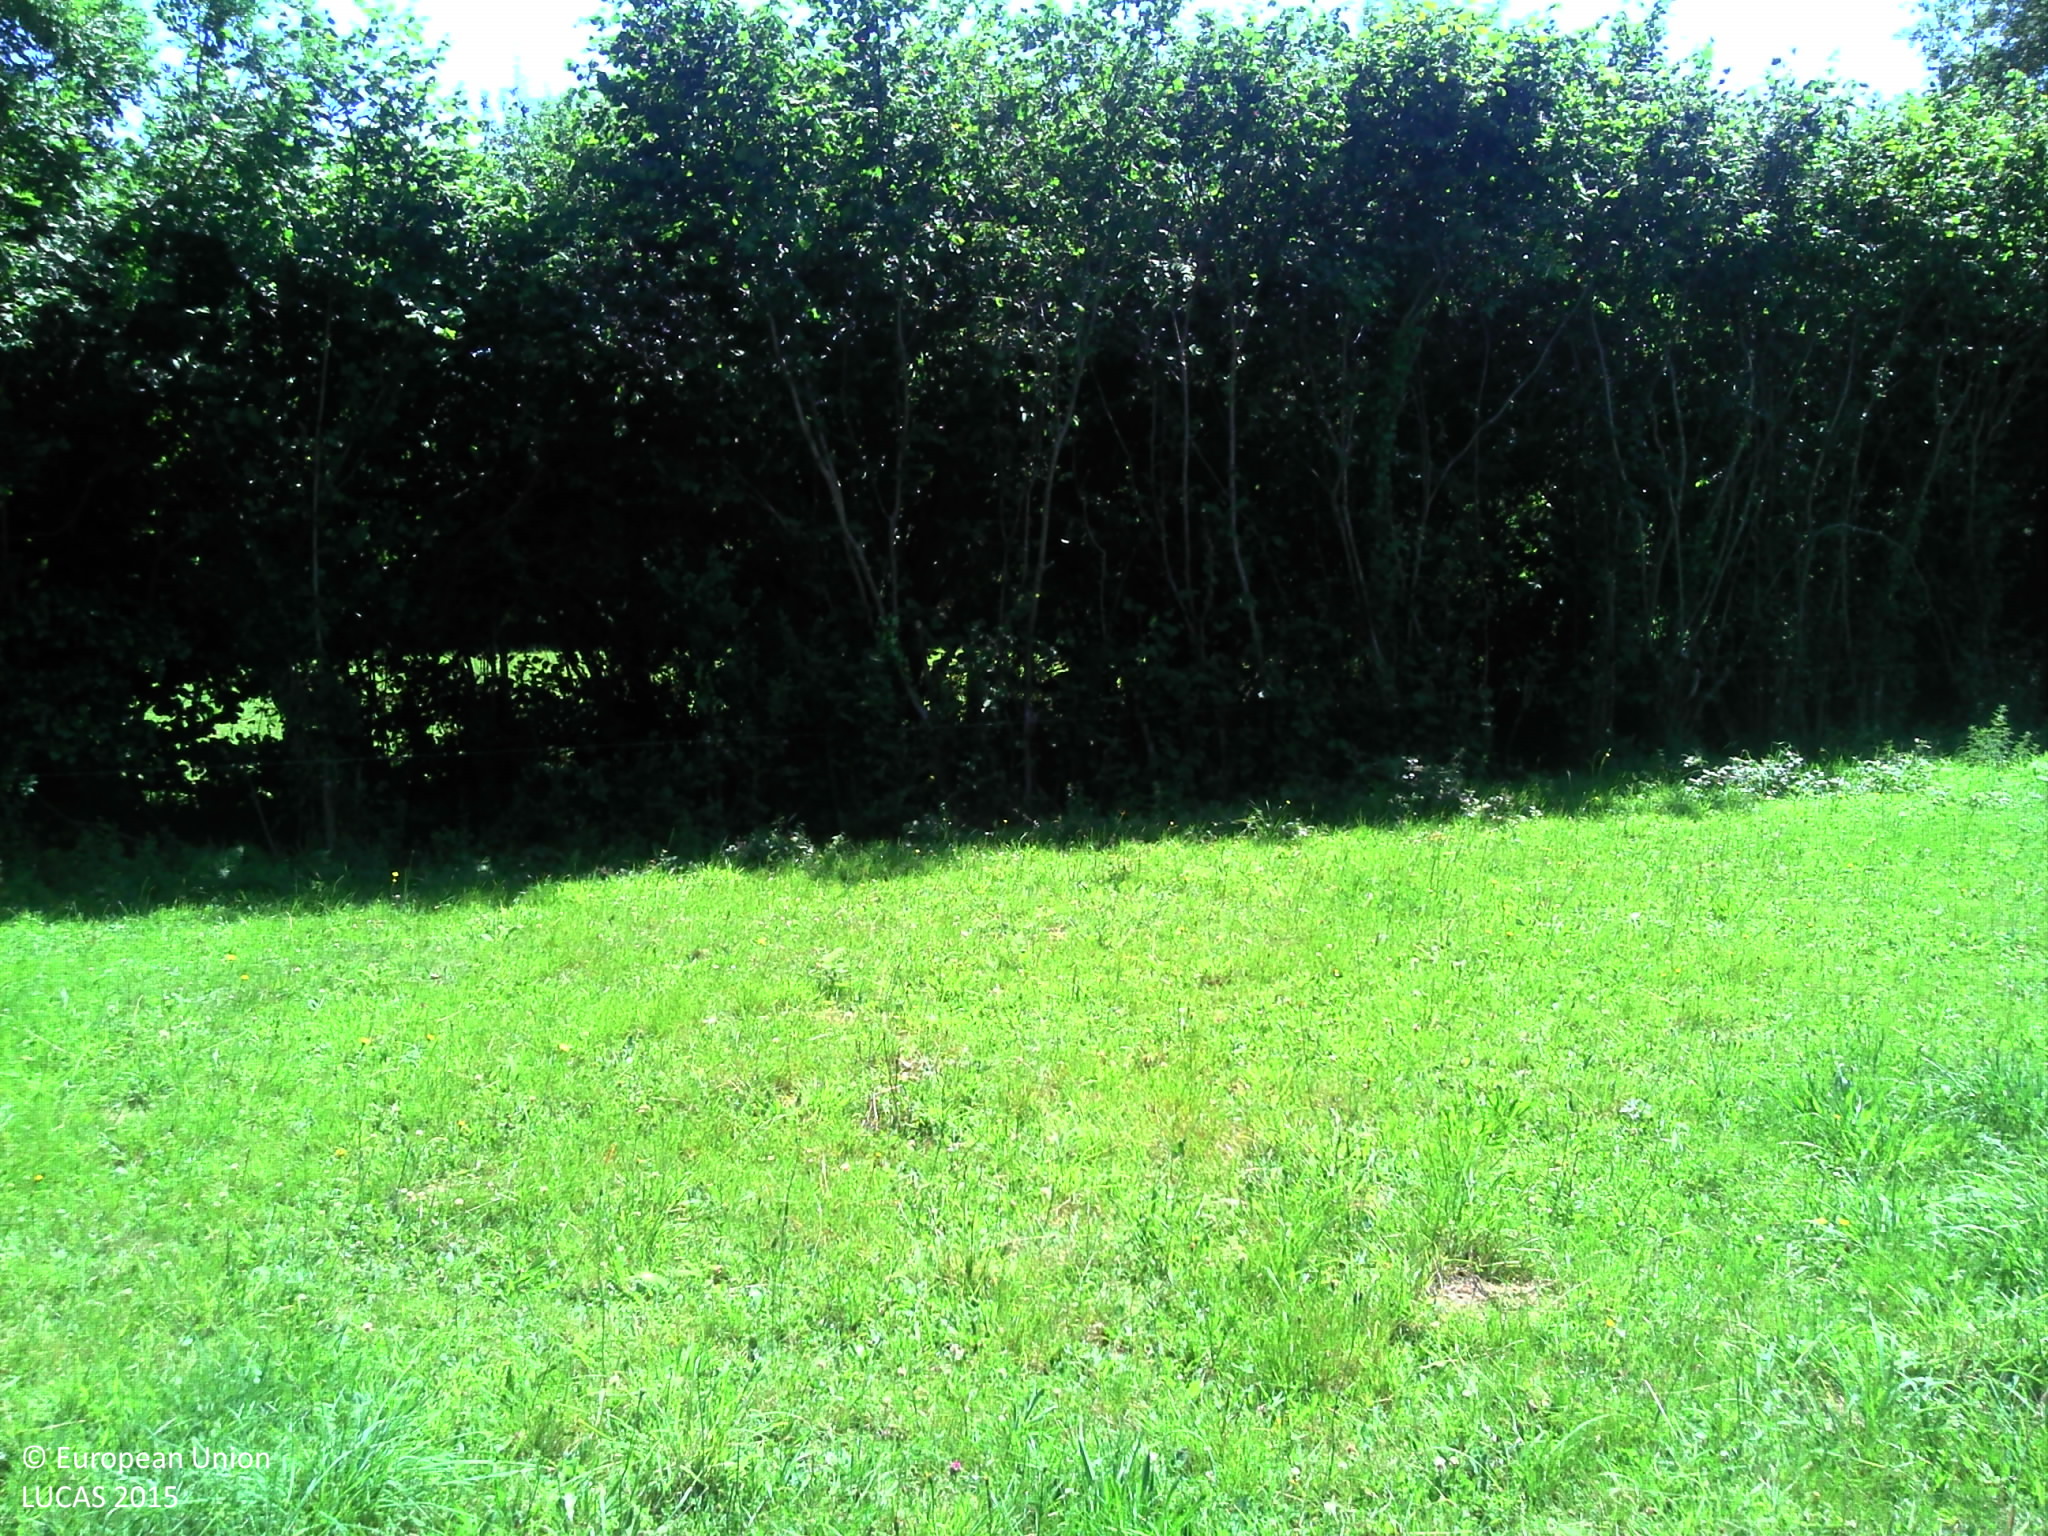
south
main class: Grassland
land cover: Grassland without tree/shrub cover
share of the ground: > 75 %
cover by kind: herbaceous plants 100 %
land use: Agriculture (excluding fallow land and kitchen gardens)
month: July
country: FR
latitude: 49.0566
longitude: -1.3083
